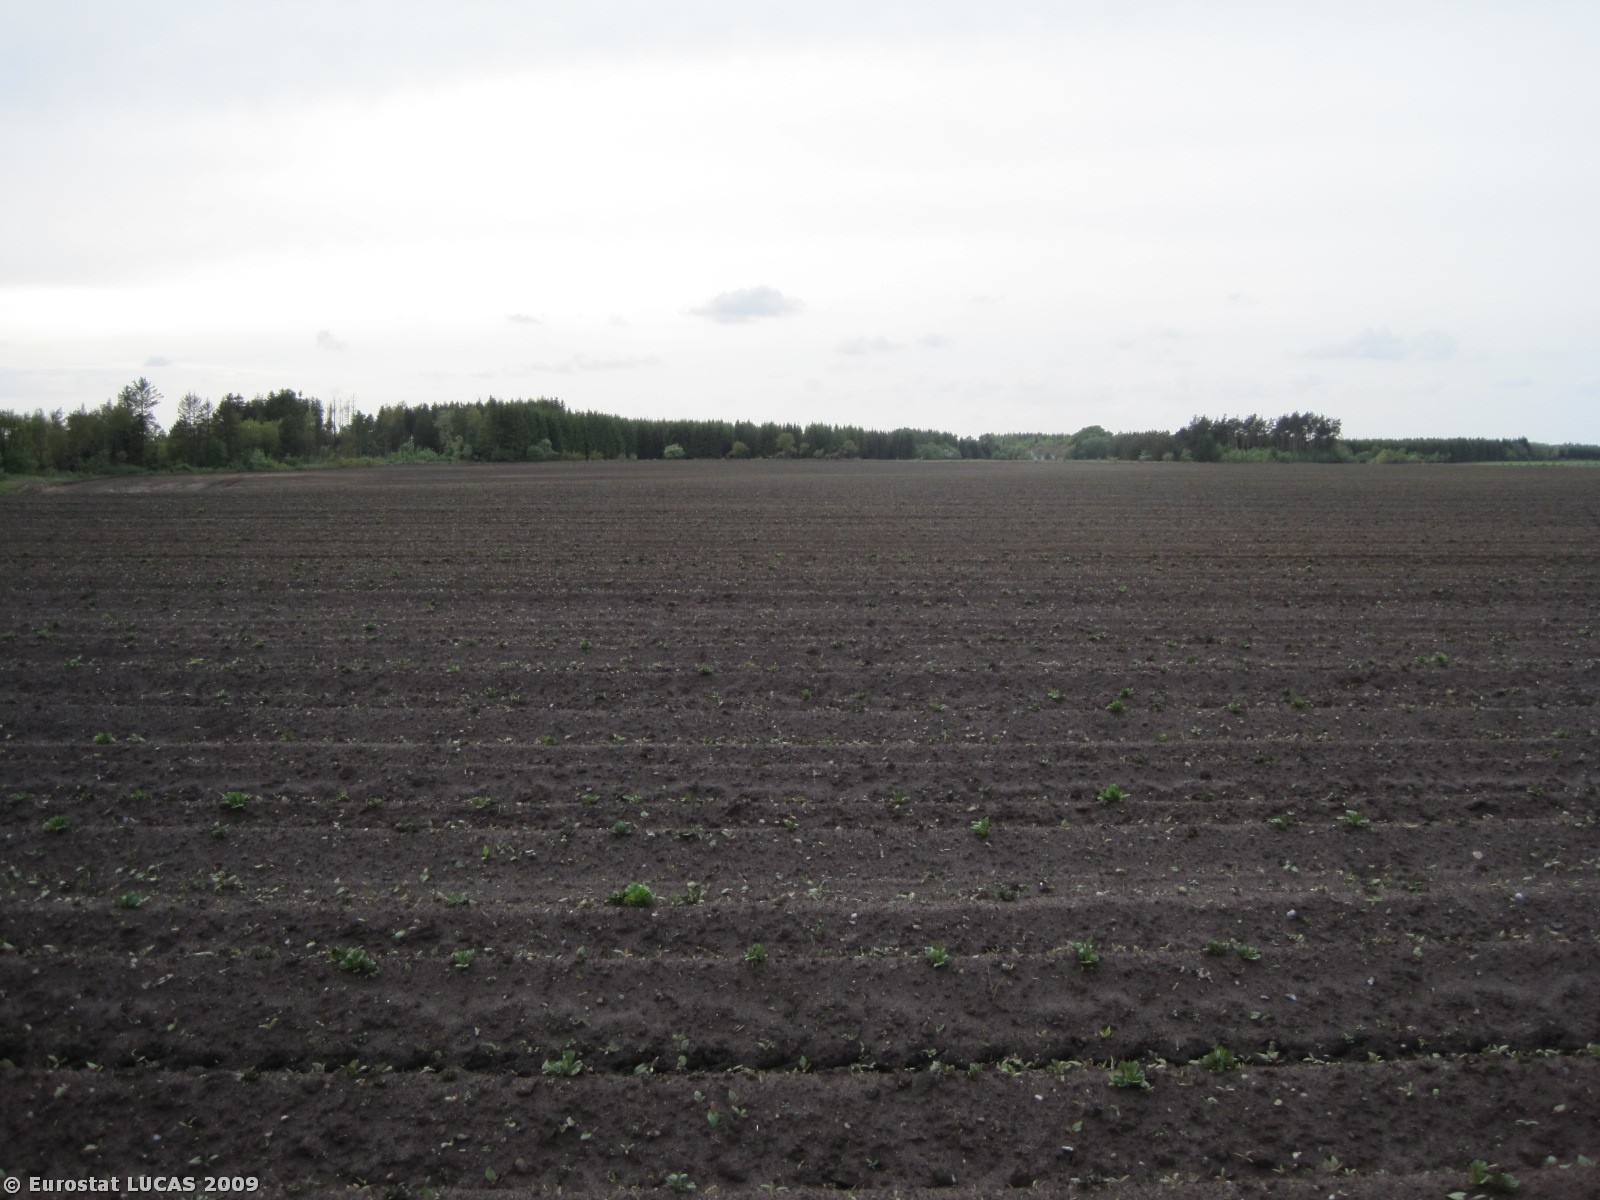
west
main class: Cropland
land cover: Potatoes
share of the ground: < 10 %
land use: Agriculture (excluding fallow land and kitchen gardens)
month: May
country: DK
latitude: 56.3830
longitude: 9.2074
